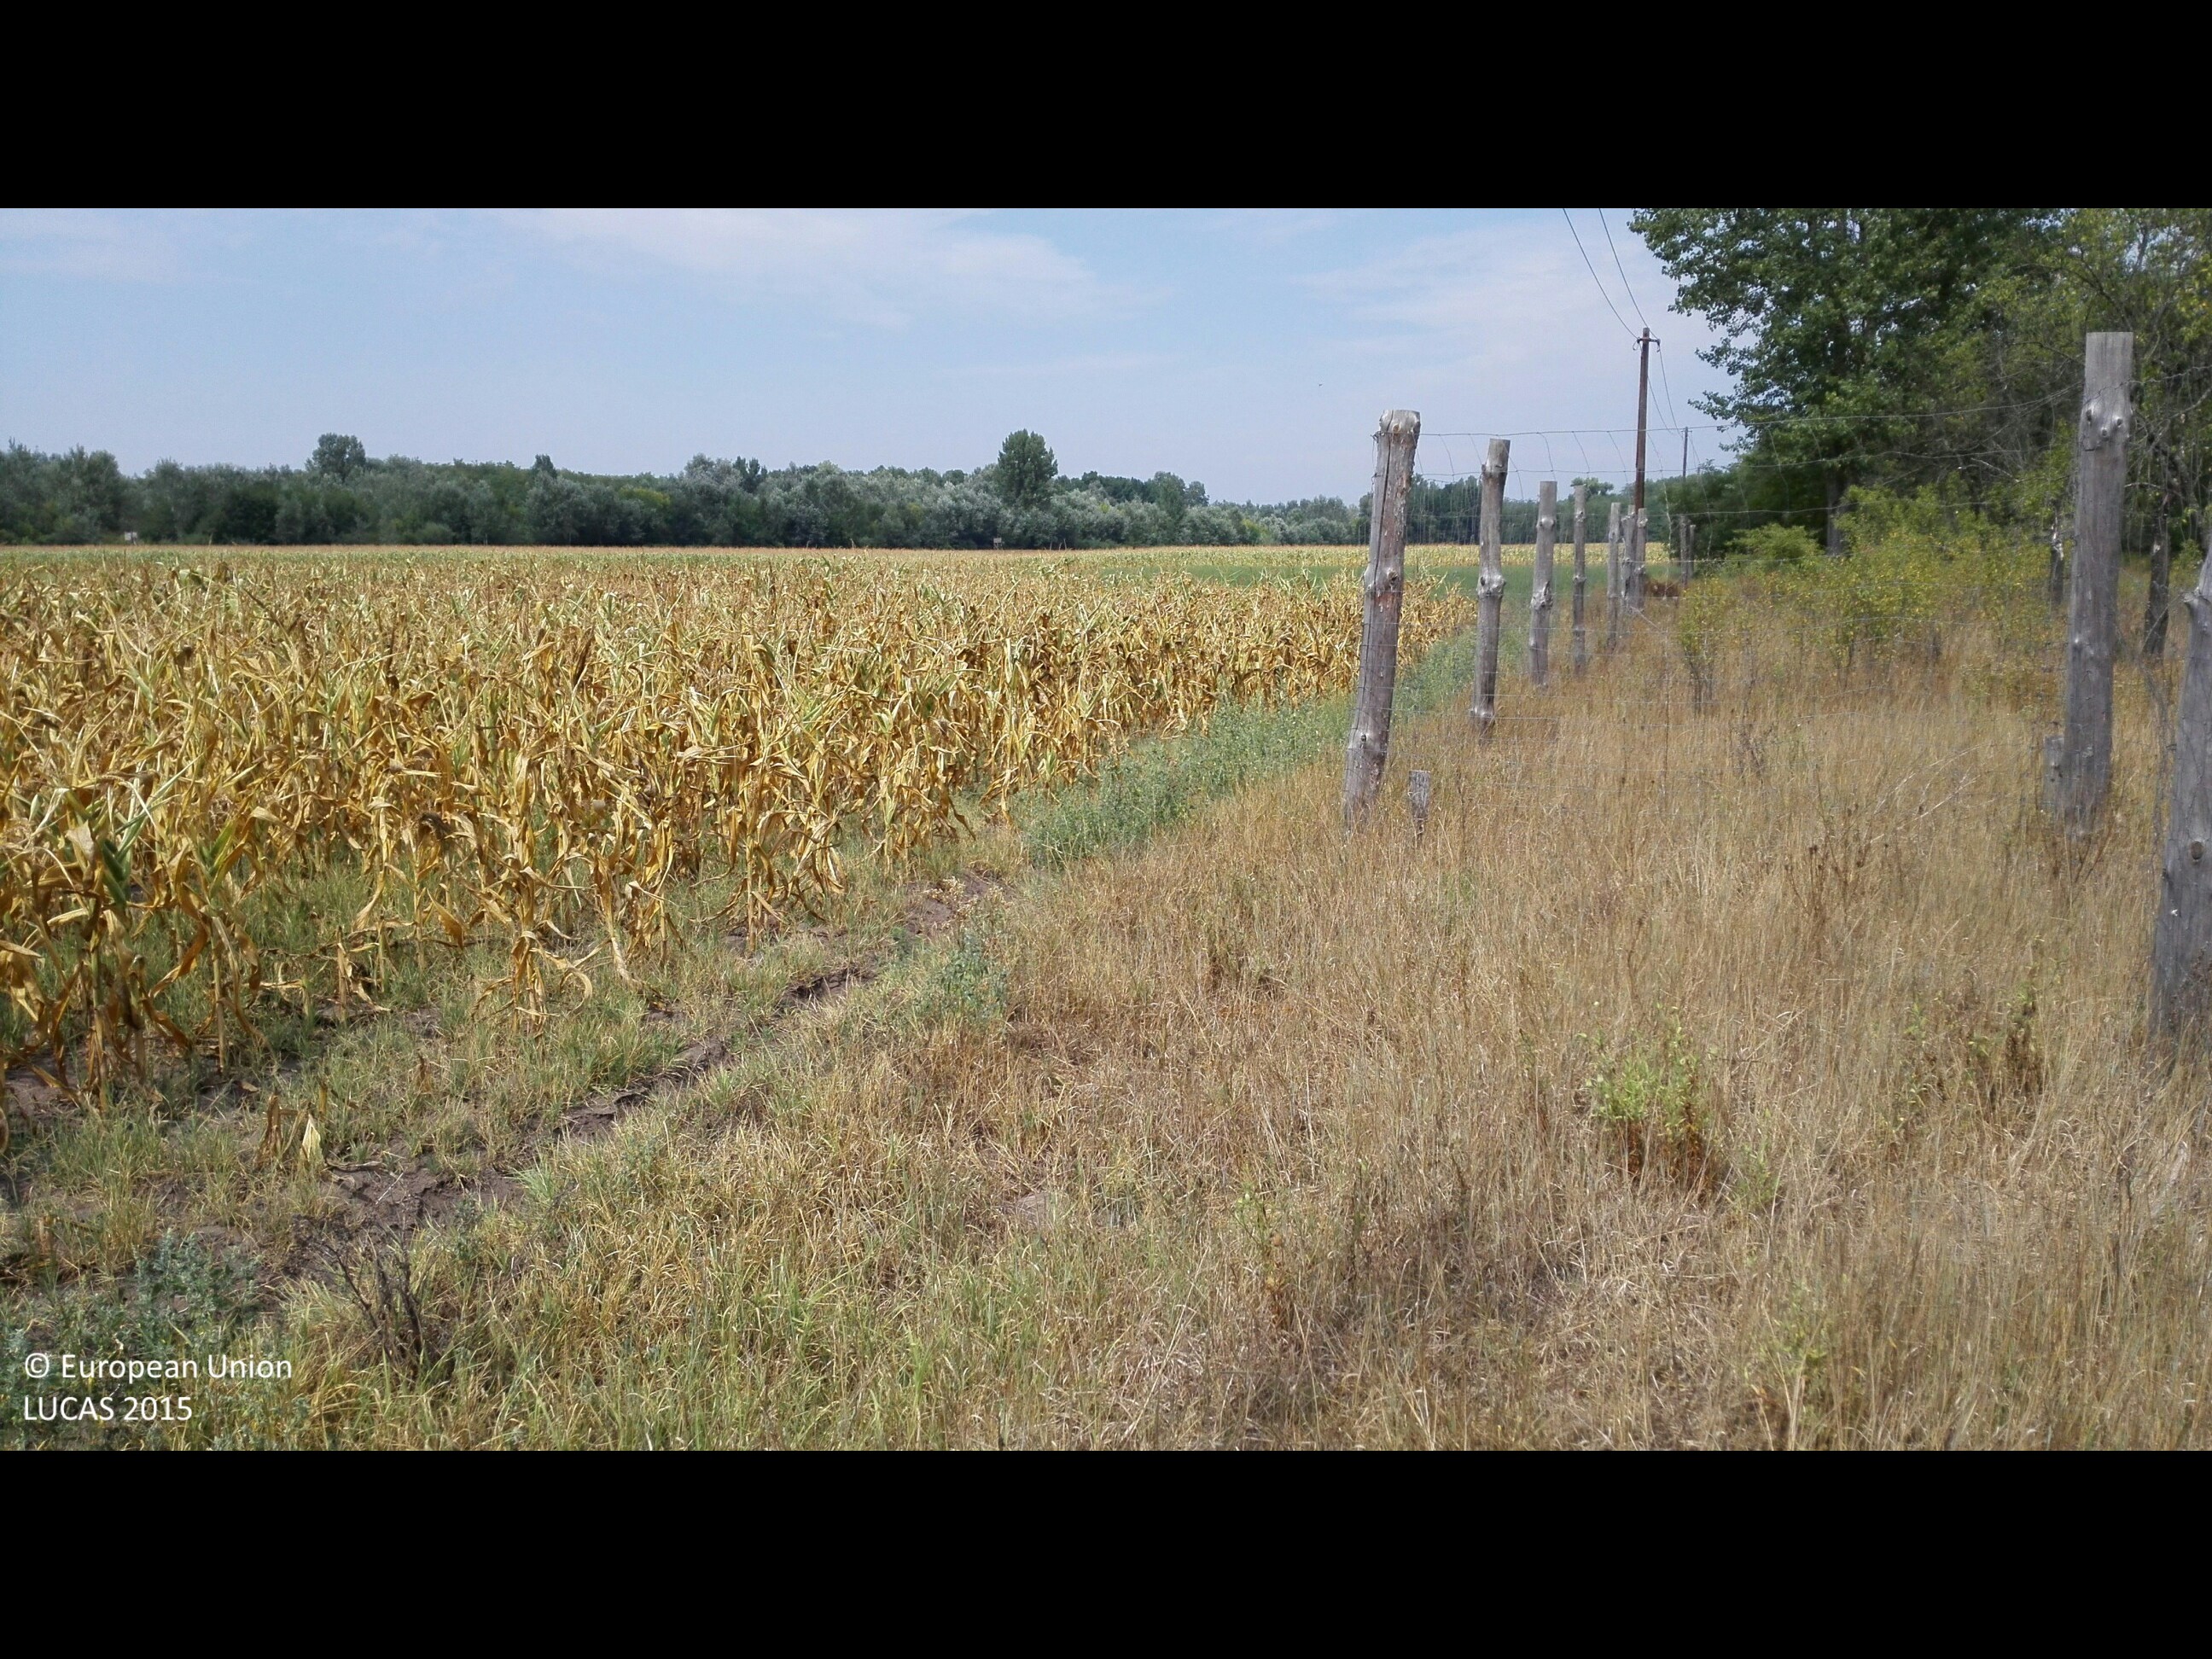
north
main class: Grassland
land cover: Grassland with sparse tree/shrub cover
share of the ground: > 75 %
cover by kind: herbaceous plants 90 %, broadleaved forest trees 5 %, shrubs 5 %
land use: Residential
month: August
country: HU
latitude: 47.5650
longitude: 21.8373
